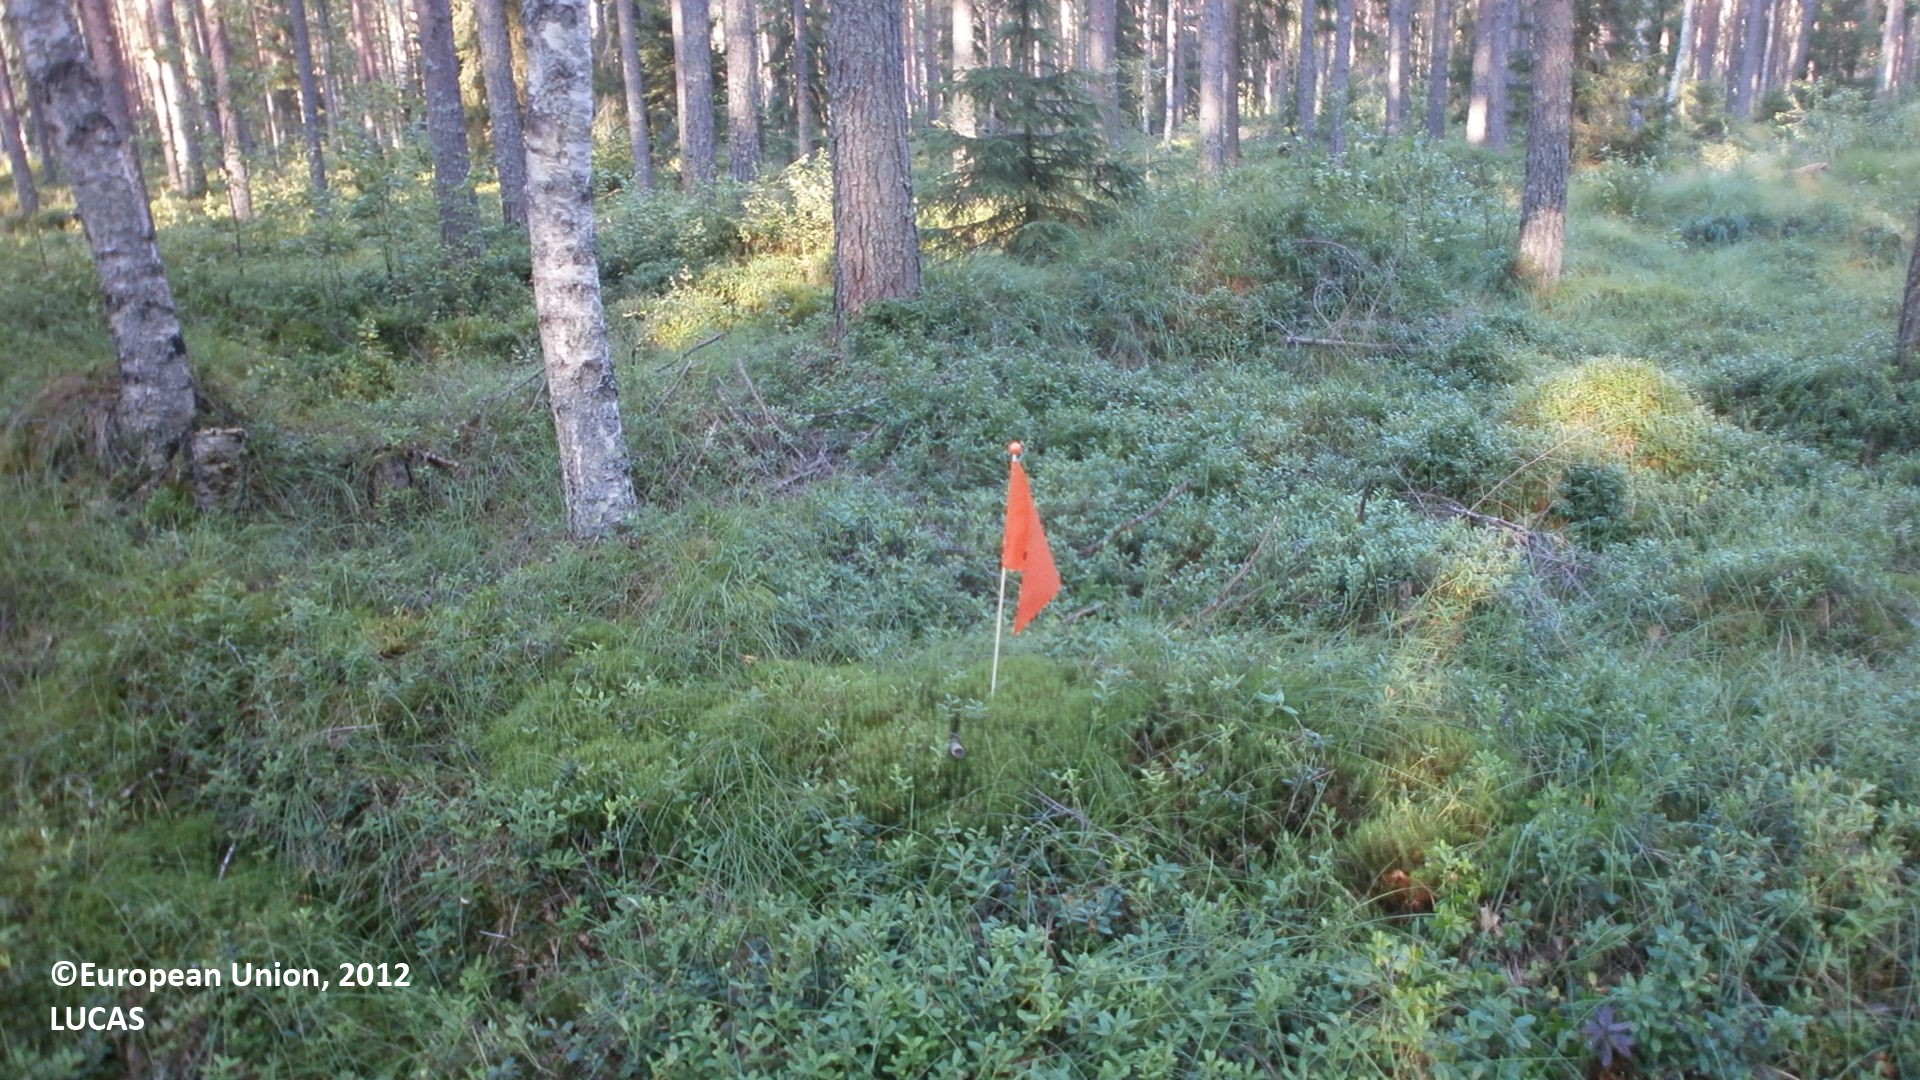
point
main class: Woodland
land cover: Pine dominated mixed woodland
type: boreal forest
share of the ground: 50 - 75 %
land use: Forestry
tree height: > 5 m
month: July
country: FI
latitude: 64.0484
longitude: 24.0129
